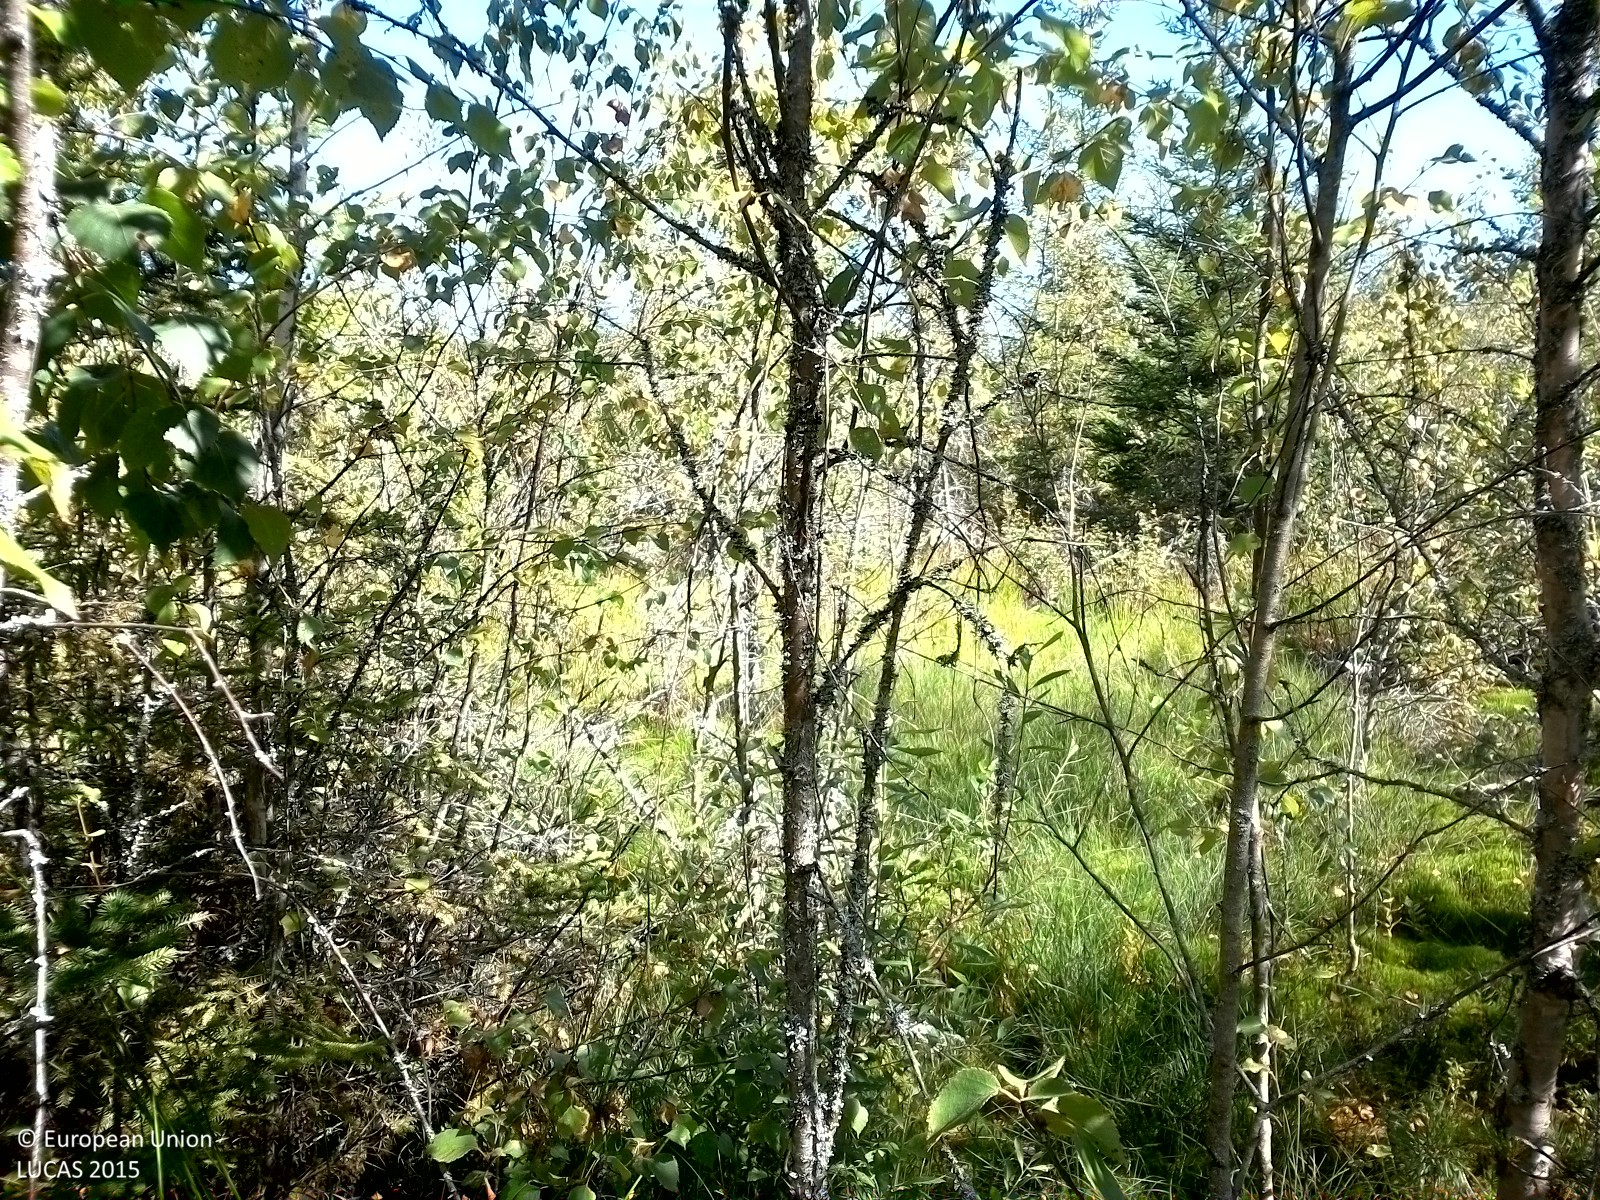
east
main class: Woodland
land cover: Spruce dominated mixed woodland
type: boreal forest
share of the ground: 50 - 75 %
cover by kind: coniferous forest trees 35 %, broadleaved forest trees 25 %, herbaceous plants 20 %, lichens and mosses 20 %
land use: Forestry
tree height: < 5 m
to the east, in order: Spruce dominated mixed woodland; Other mixed woodland; Broadleaved woodland; Dry stone walls; Spruce dominated mixed woodland; Ditches and canals; Grass margins; Rape and turnip rape
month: August
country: SE
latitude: 59.2111
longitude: 15.4040
